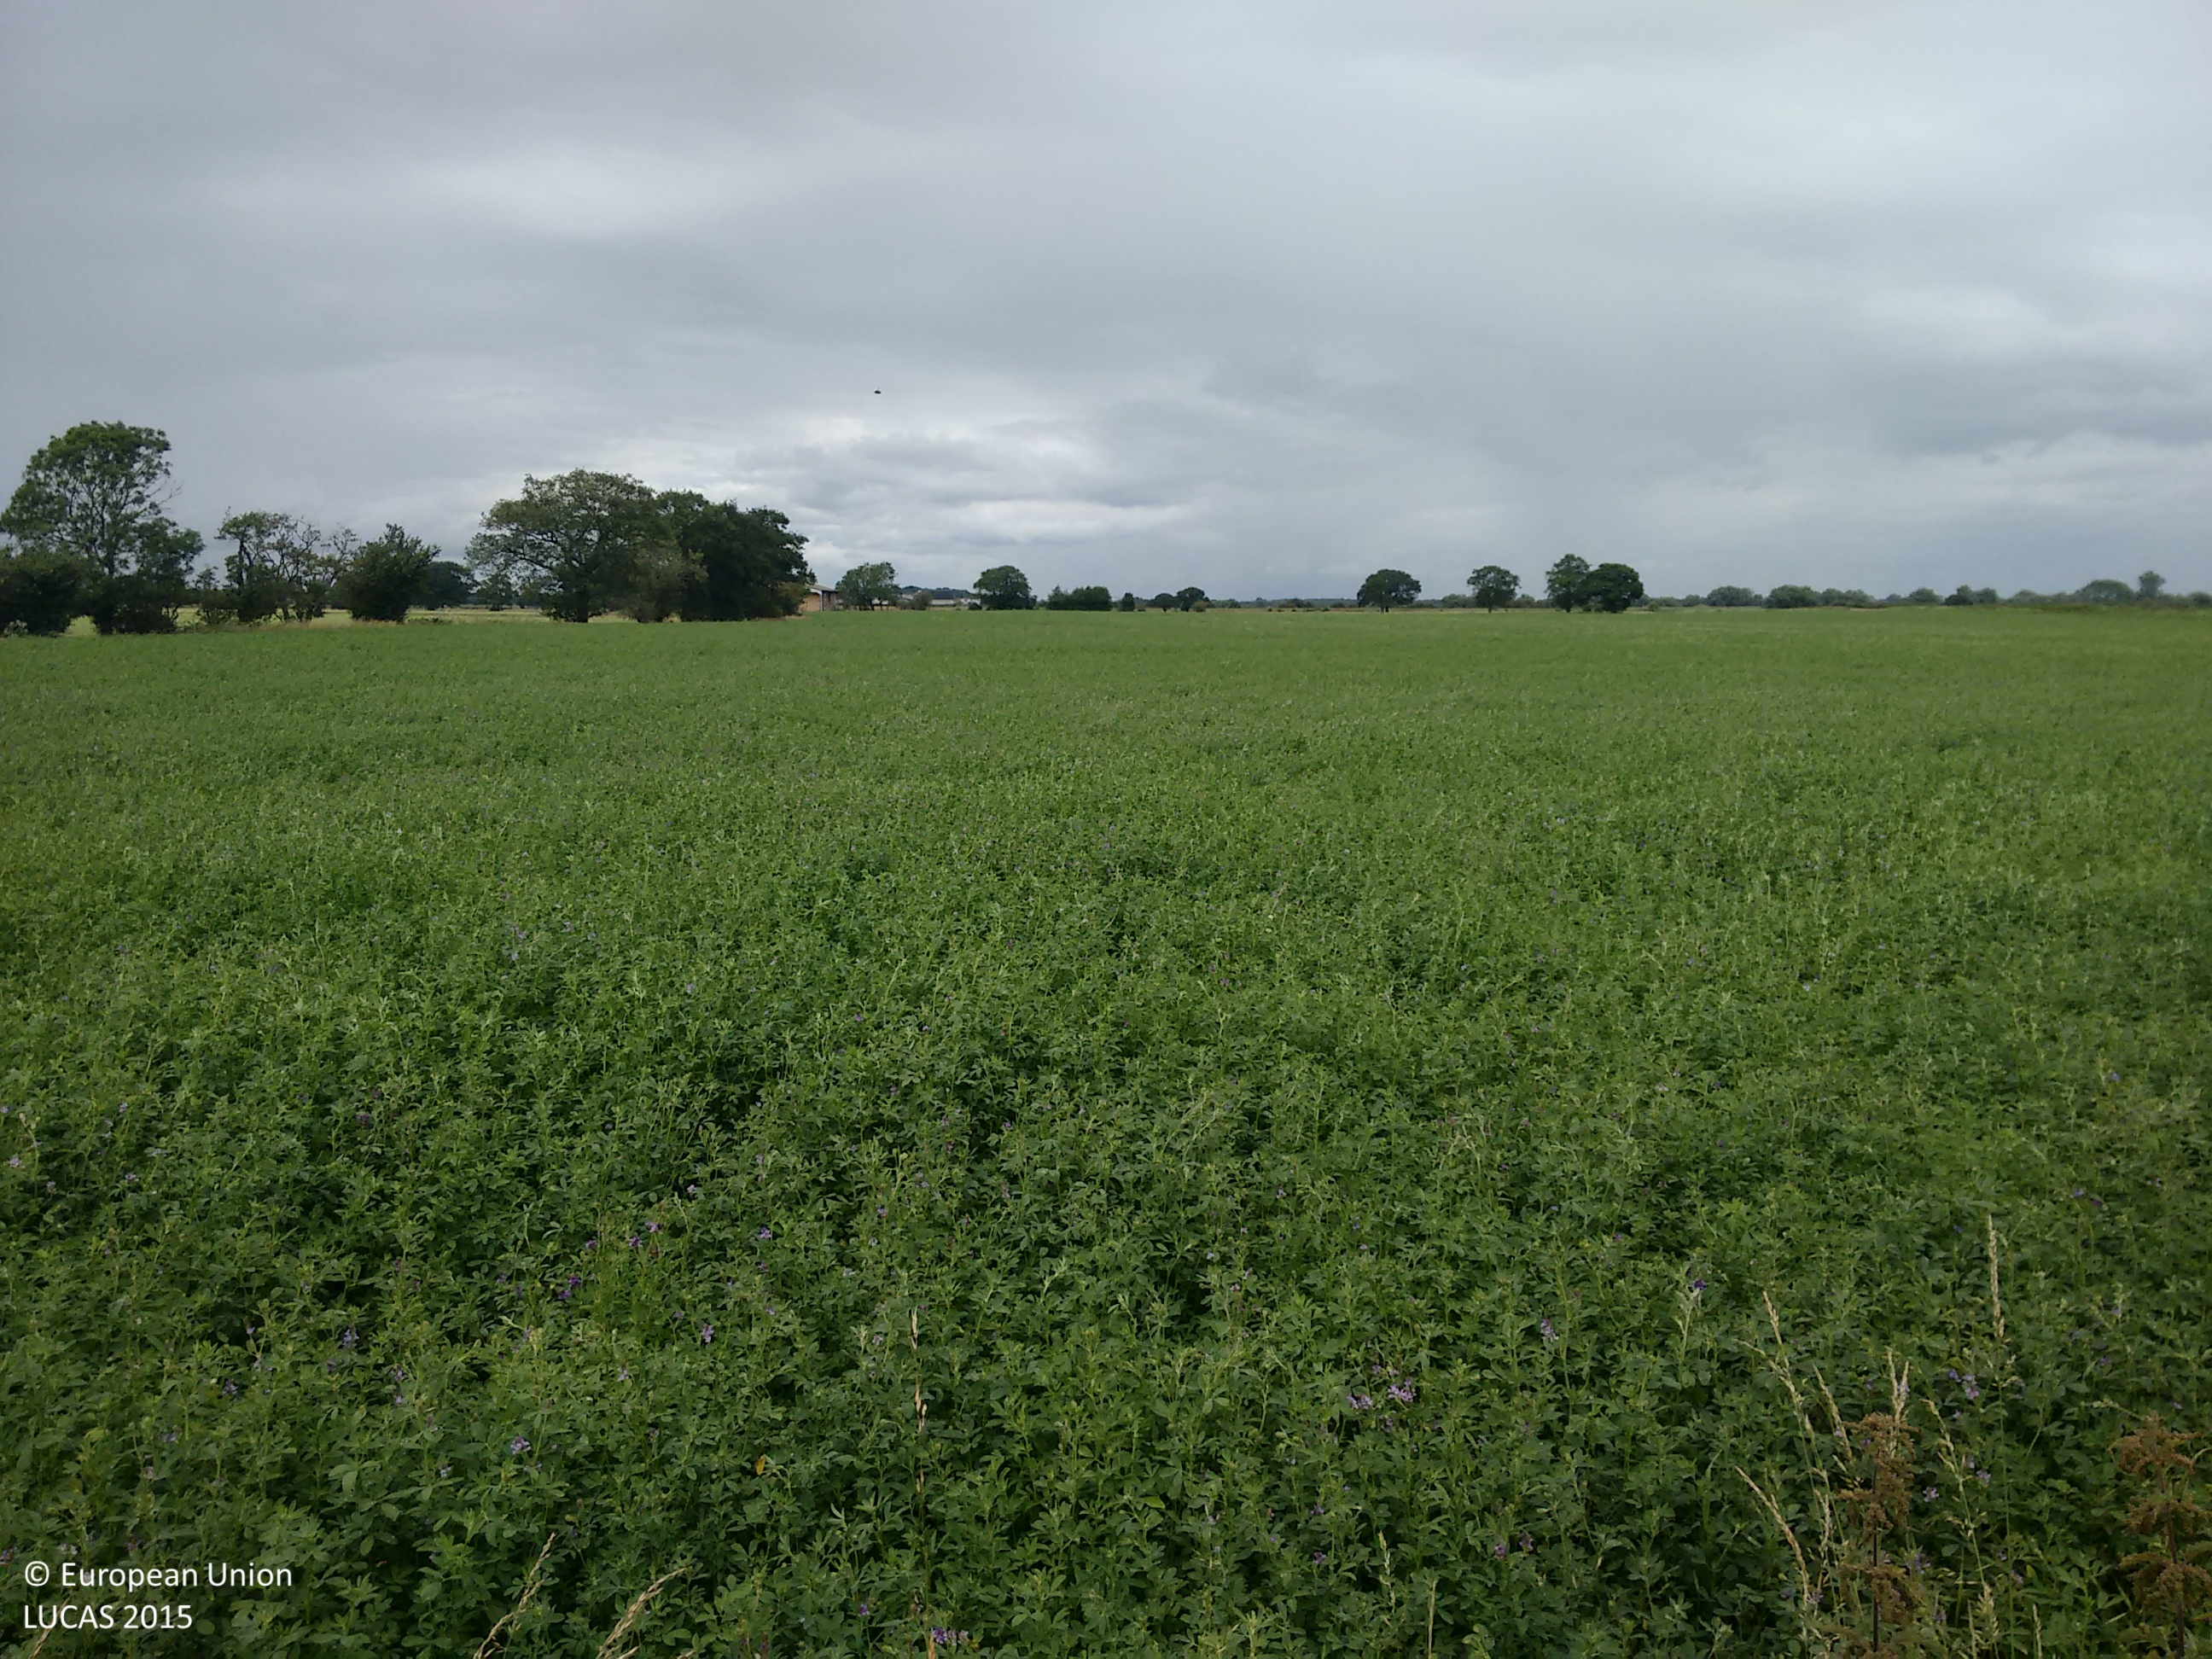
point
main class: Cropland
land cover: Other fibre and oleaginous crops
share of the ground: > 75 %
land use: Agriculture (excluding fallow land and kitchen gardens)
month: July
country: GB
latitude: 53.4270
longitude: -0.9843
